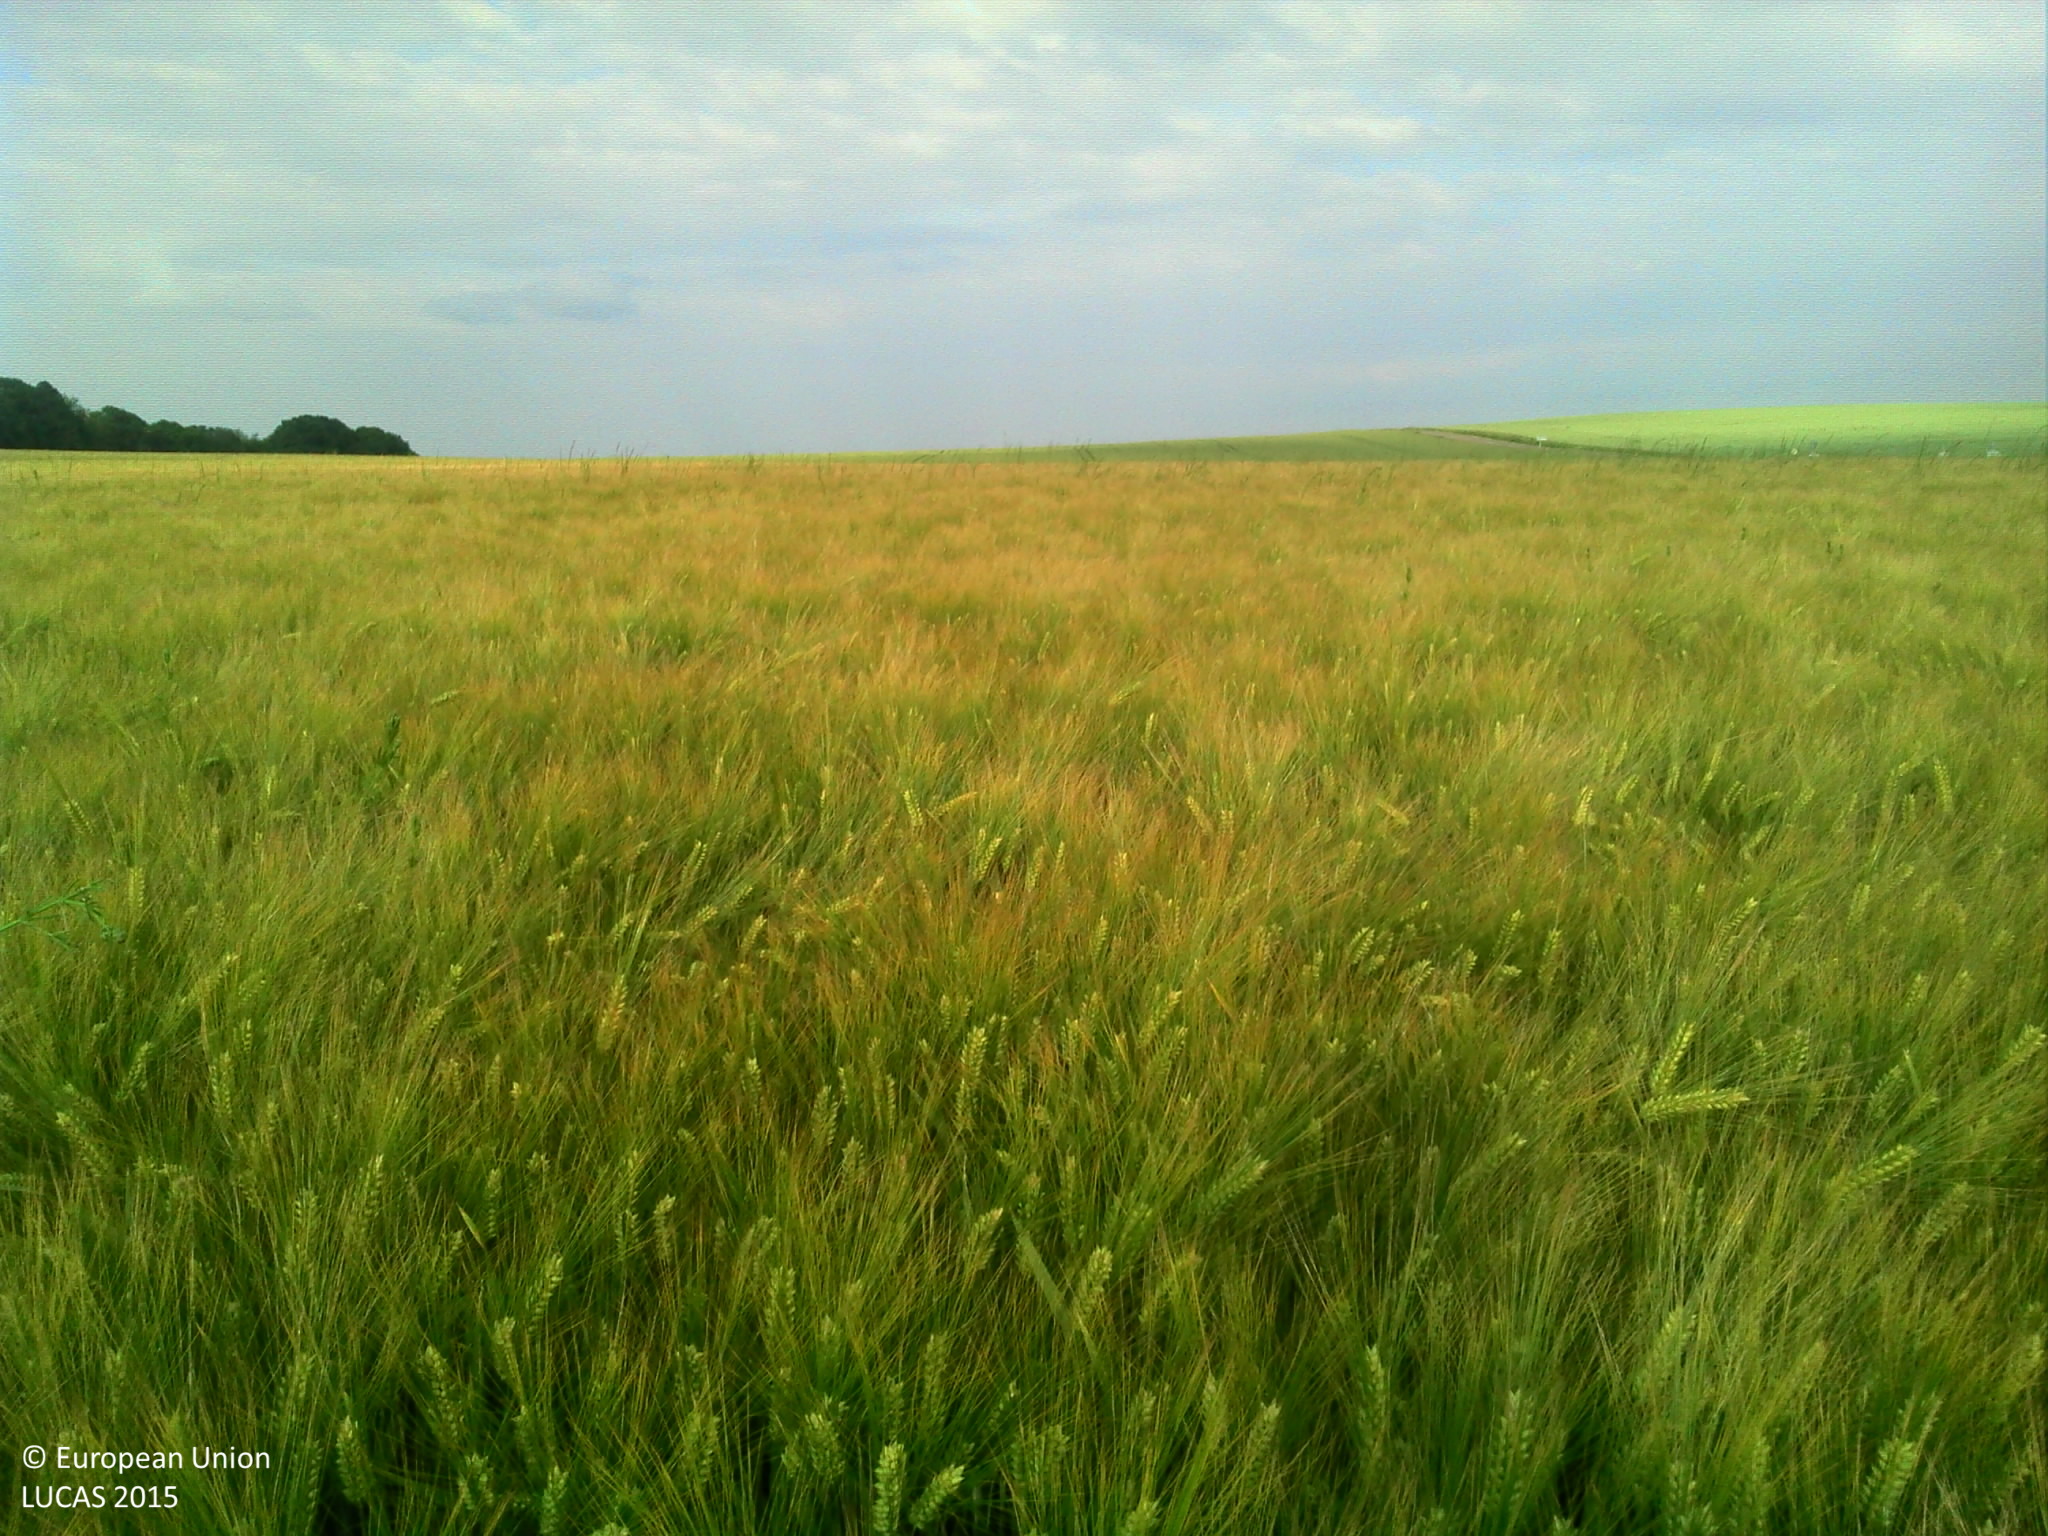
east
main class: Cropland
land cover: Barley
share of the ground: > 75 %
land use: Agriculture (excluding fallow land and kitchen gardens)
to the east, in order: Barley; Ditches and canals; Grass margins; Paved roads, cycling and walking lanes
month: June
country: FR
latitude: 48.4363
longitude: 5.0379
